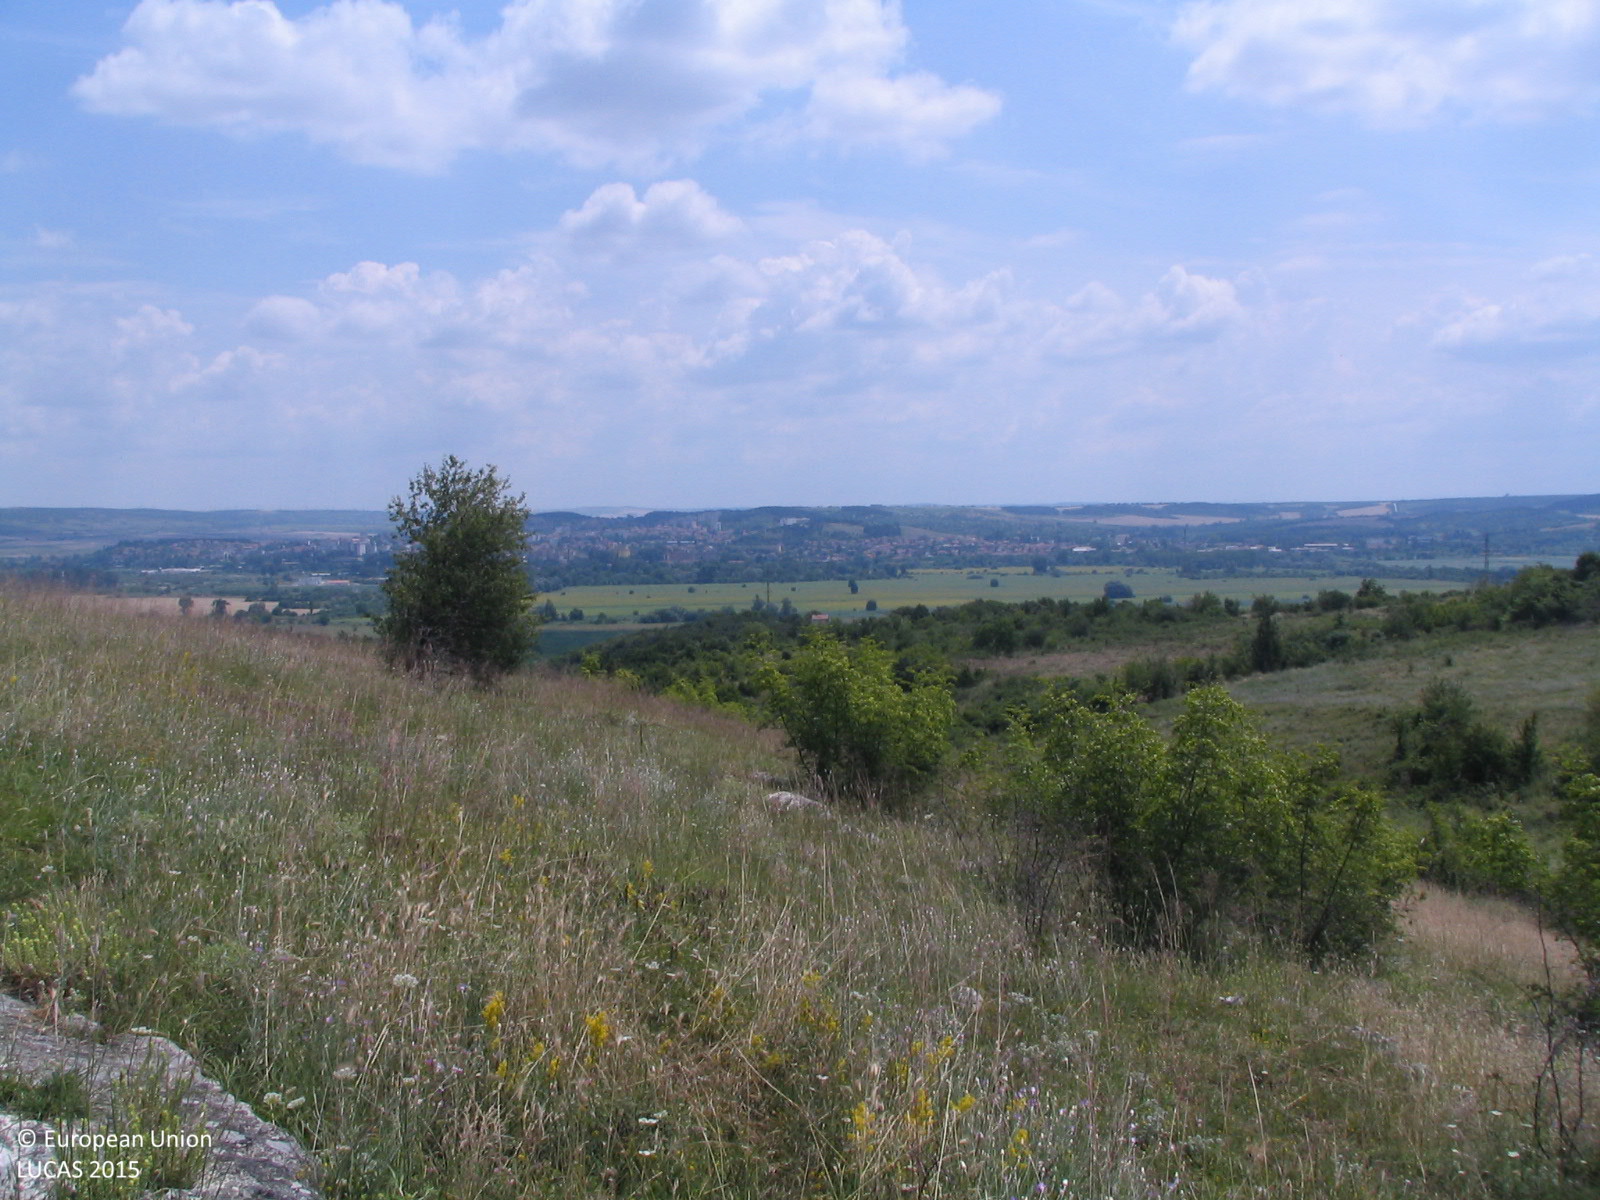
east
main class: Grassland
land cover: Grassland with sparse tree/shrub cover
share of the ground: > 75 %
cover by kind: herbaceous plants 85 %, shrubs 10 %, broadleaved forest trees 5 %
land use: Agriculture (excluding fallow land and kitchen gardens)
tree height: < 5 m
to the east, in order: Grassland with sparse tree/shrub cover; Tracks; Grassland with sparse tree/shrub cover
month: June
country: BG
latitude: 43.2811
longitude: 24.0379
